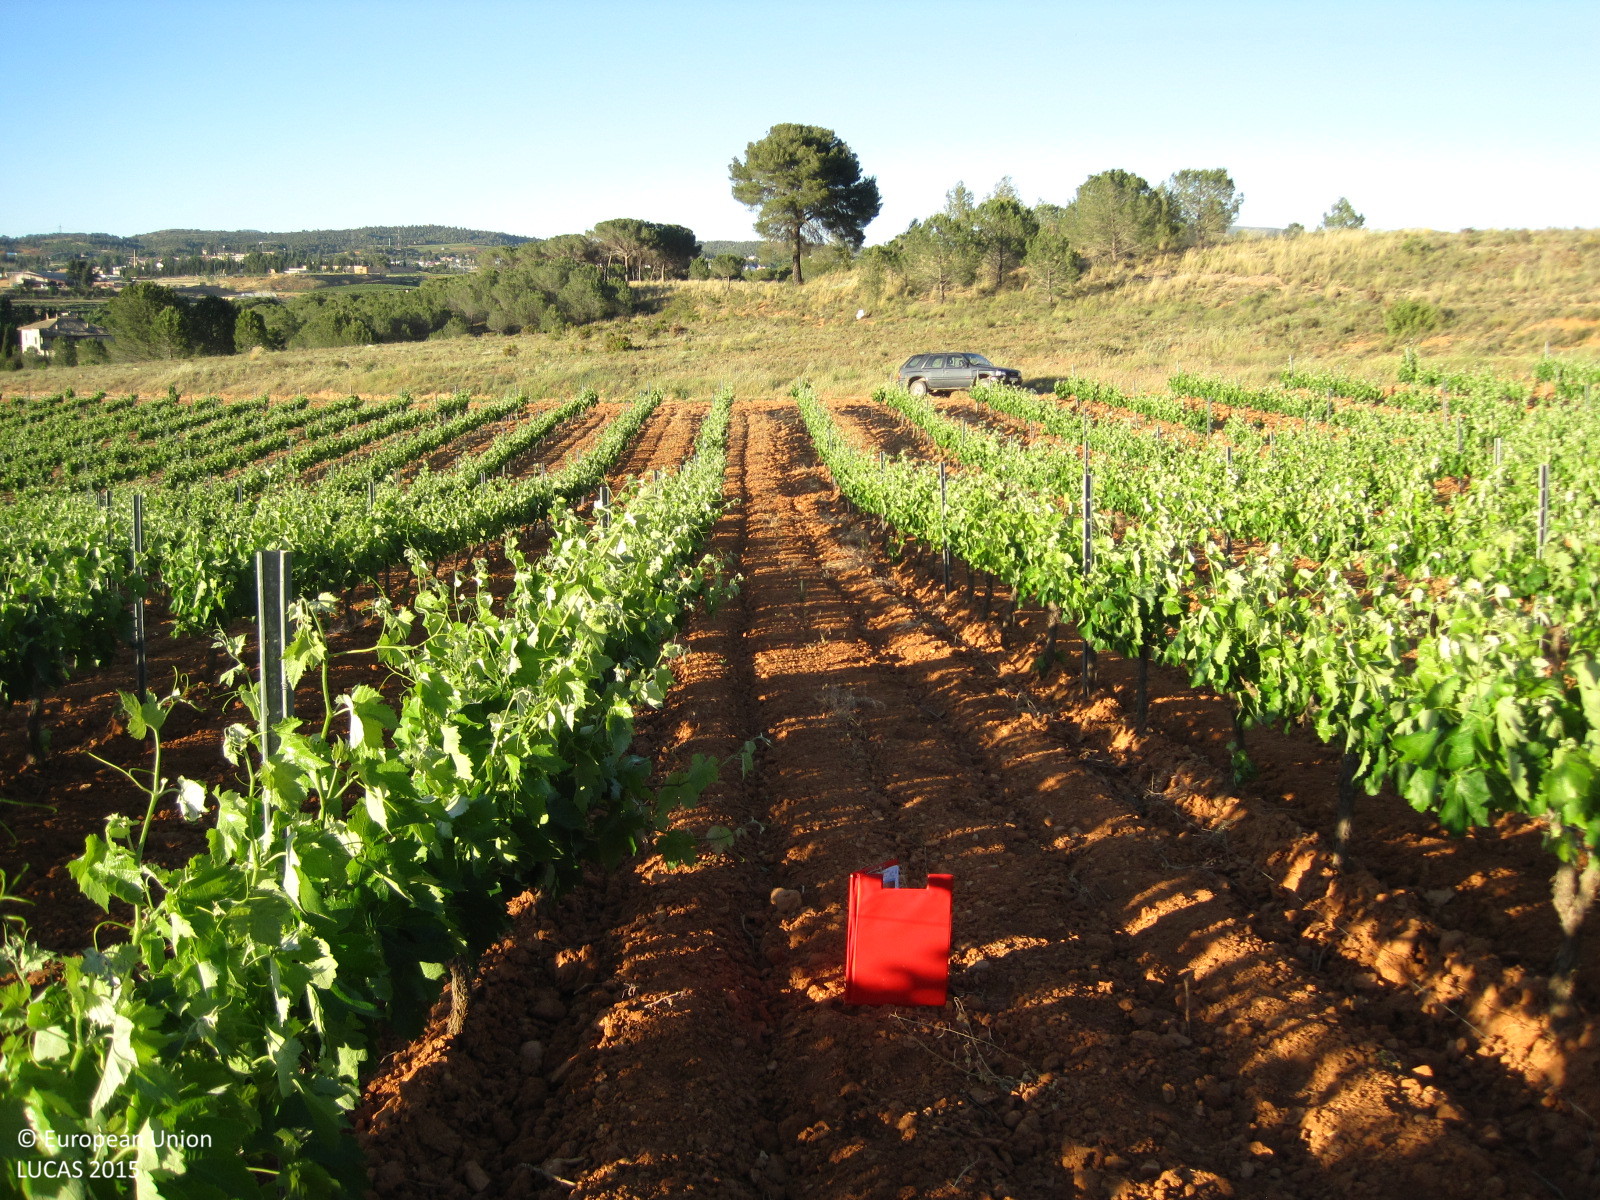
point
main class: Artificial land
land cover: Other artificial areas
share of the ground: > 75 %
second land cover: Vineyards
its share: 25 - 50 %
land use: Electricity, gas and thermal power distribution
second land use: Agriculture (excluding fallow land and kitchen gardens)
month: May
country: ES
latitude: 39.4709
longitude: -1.1021
